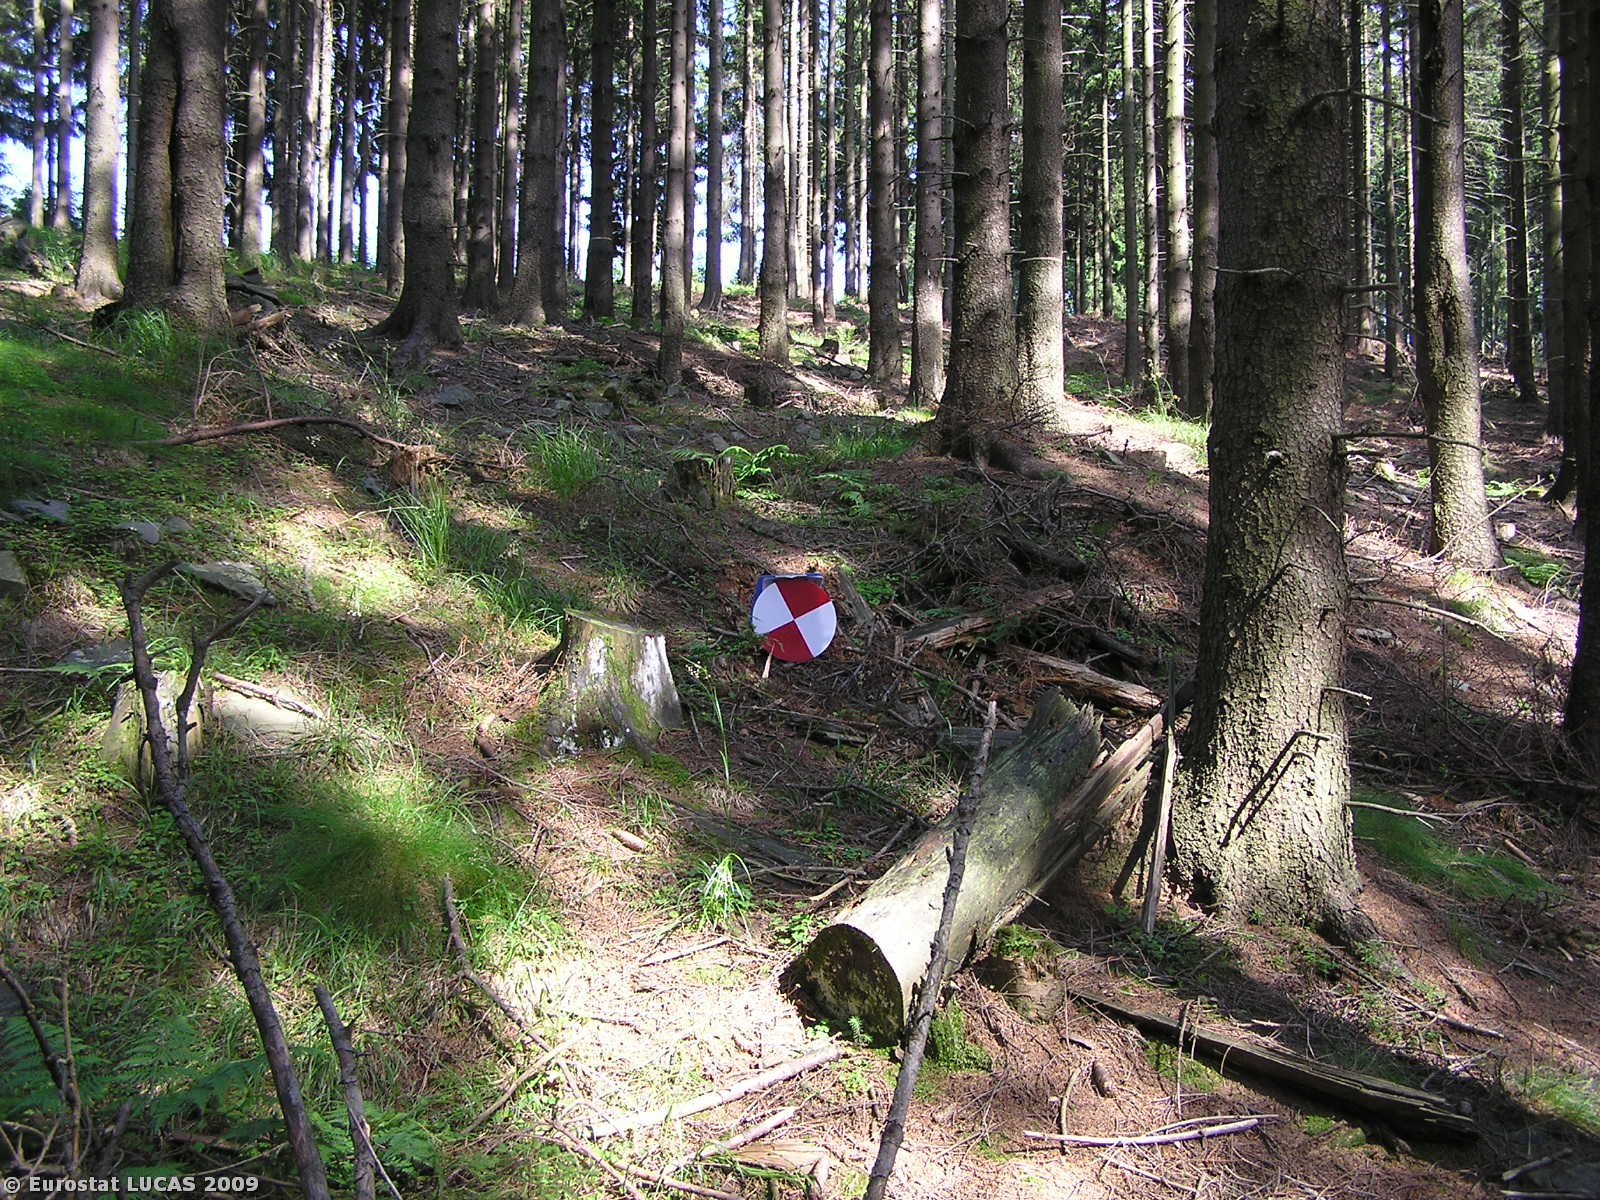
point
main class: Woodland
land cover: Coniferous woodland
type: hemiboreal forest and nemoral coniferous forest and mixed broadleaved-coniferous forest
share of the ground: > 75 %
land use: Forestry
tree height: > 5 m
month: July
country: CZ
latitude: 50.1611
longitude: 17.3889
